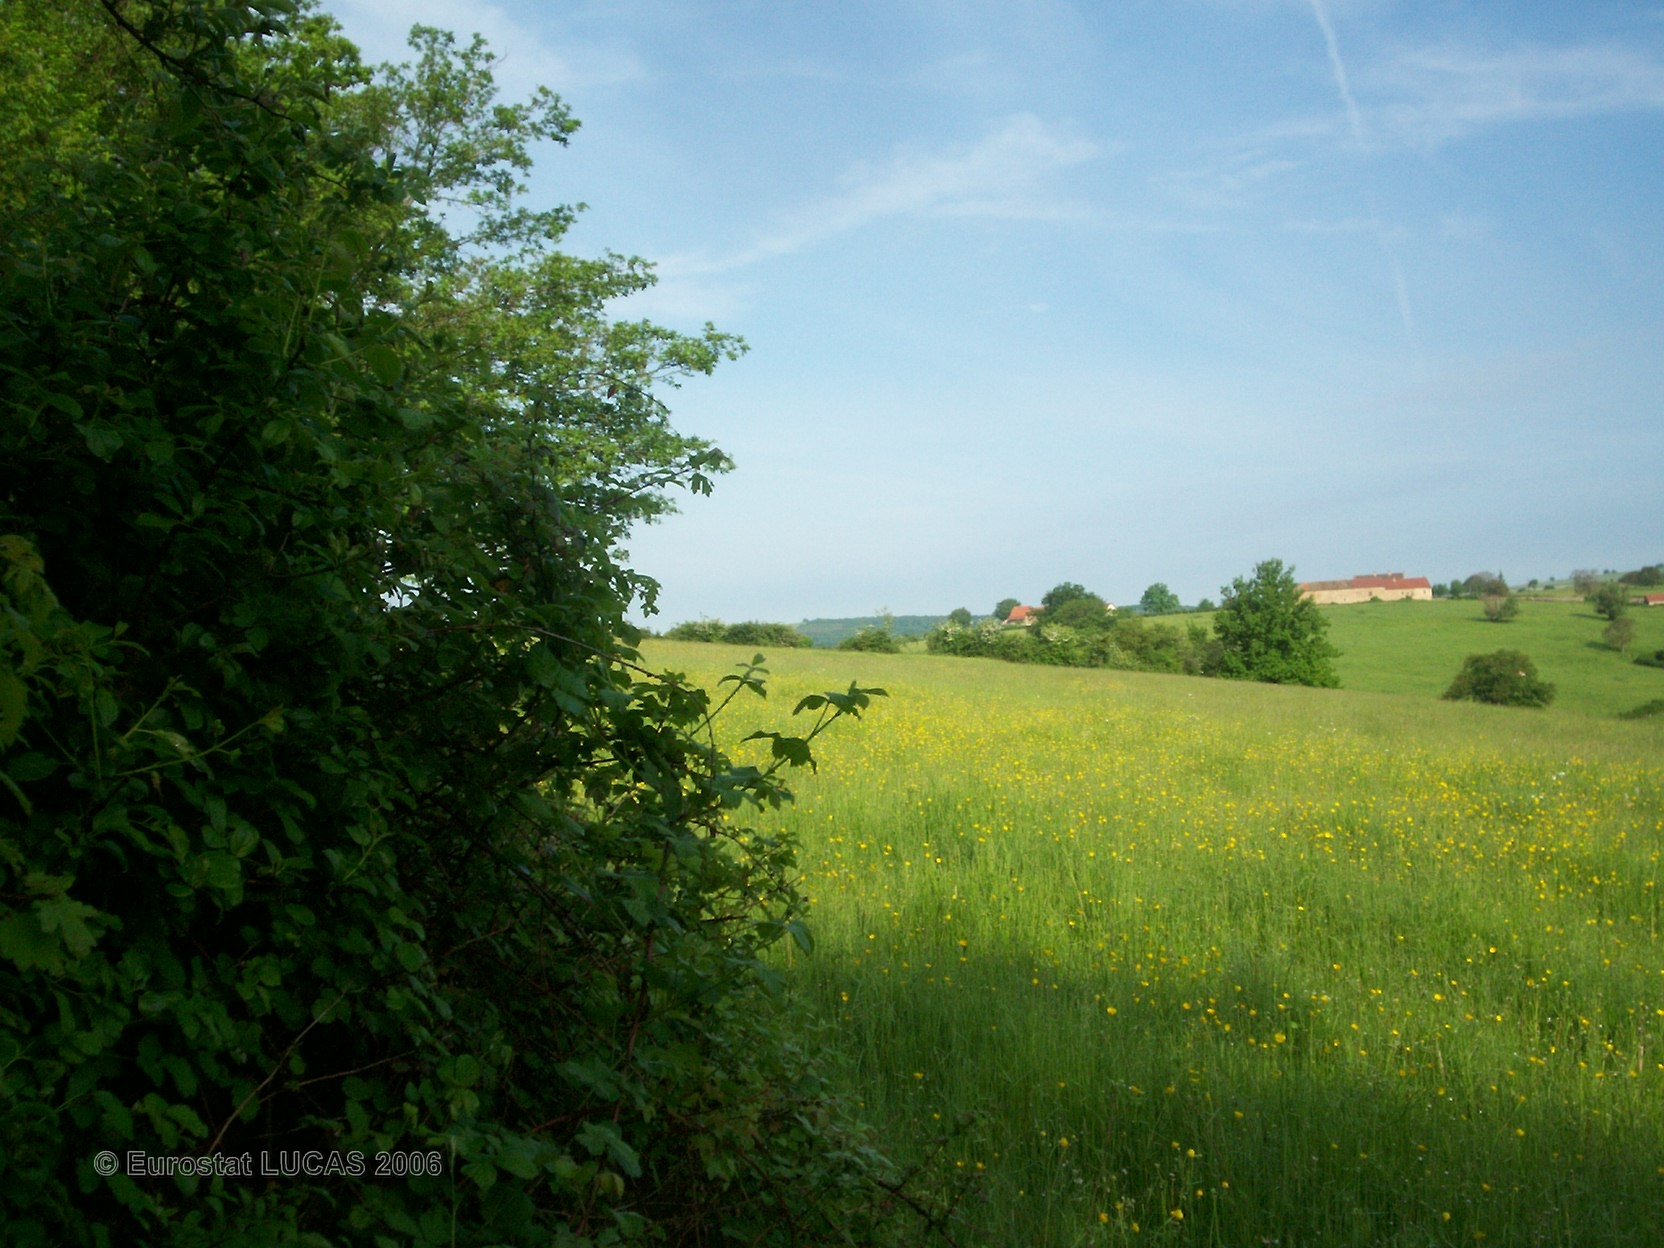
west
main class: Grassland
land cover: Grassland without tree/shrub cover
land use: Agriculture (excluding fallow land and kitchen gardens)
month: May
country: FR
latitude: 46.7214
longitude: 4.6238
